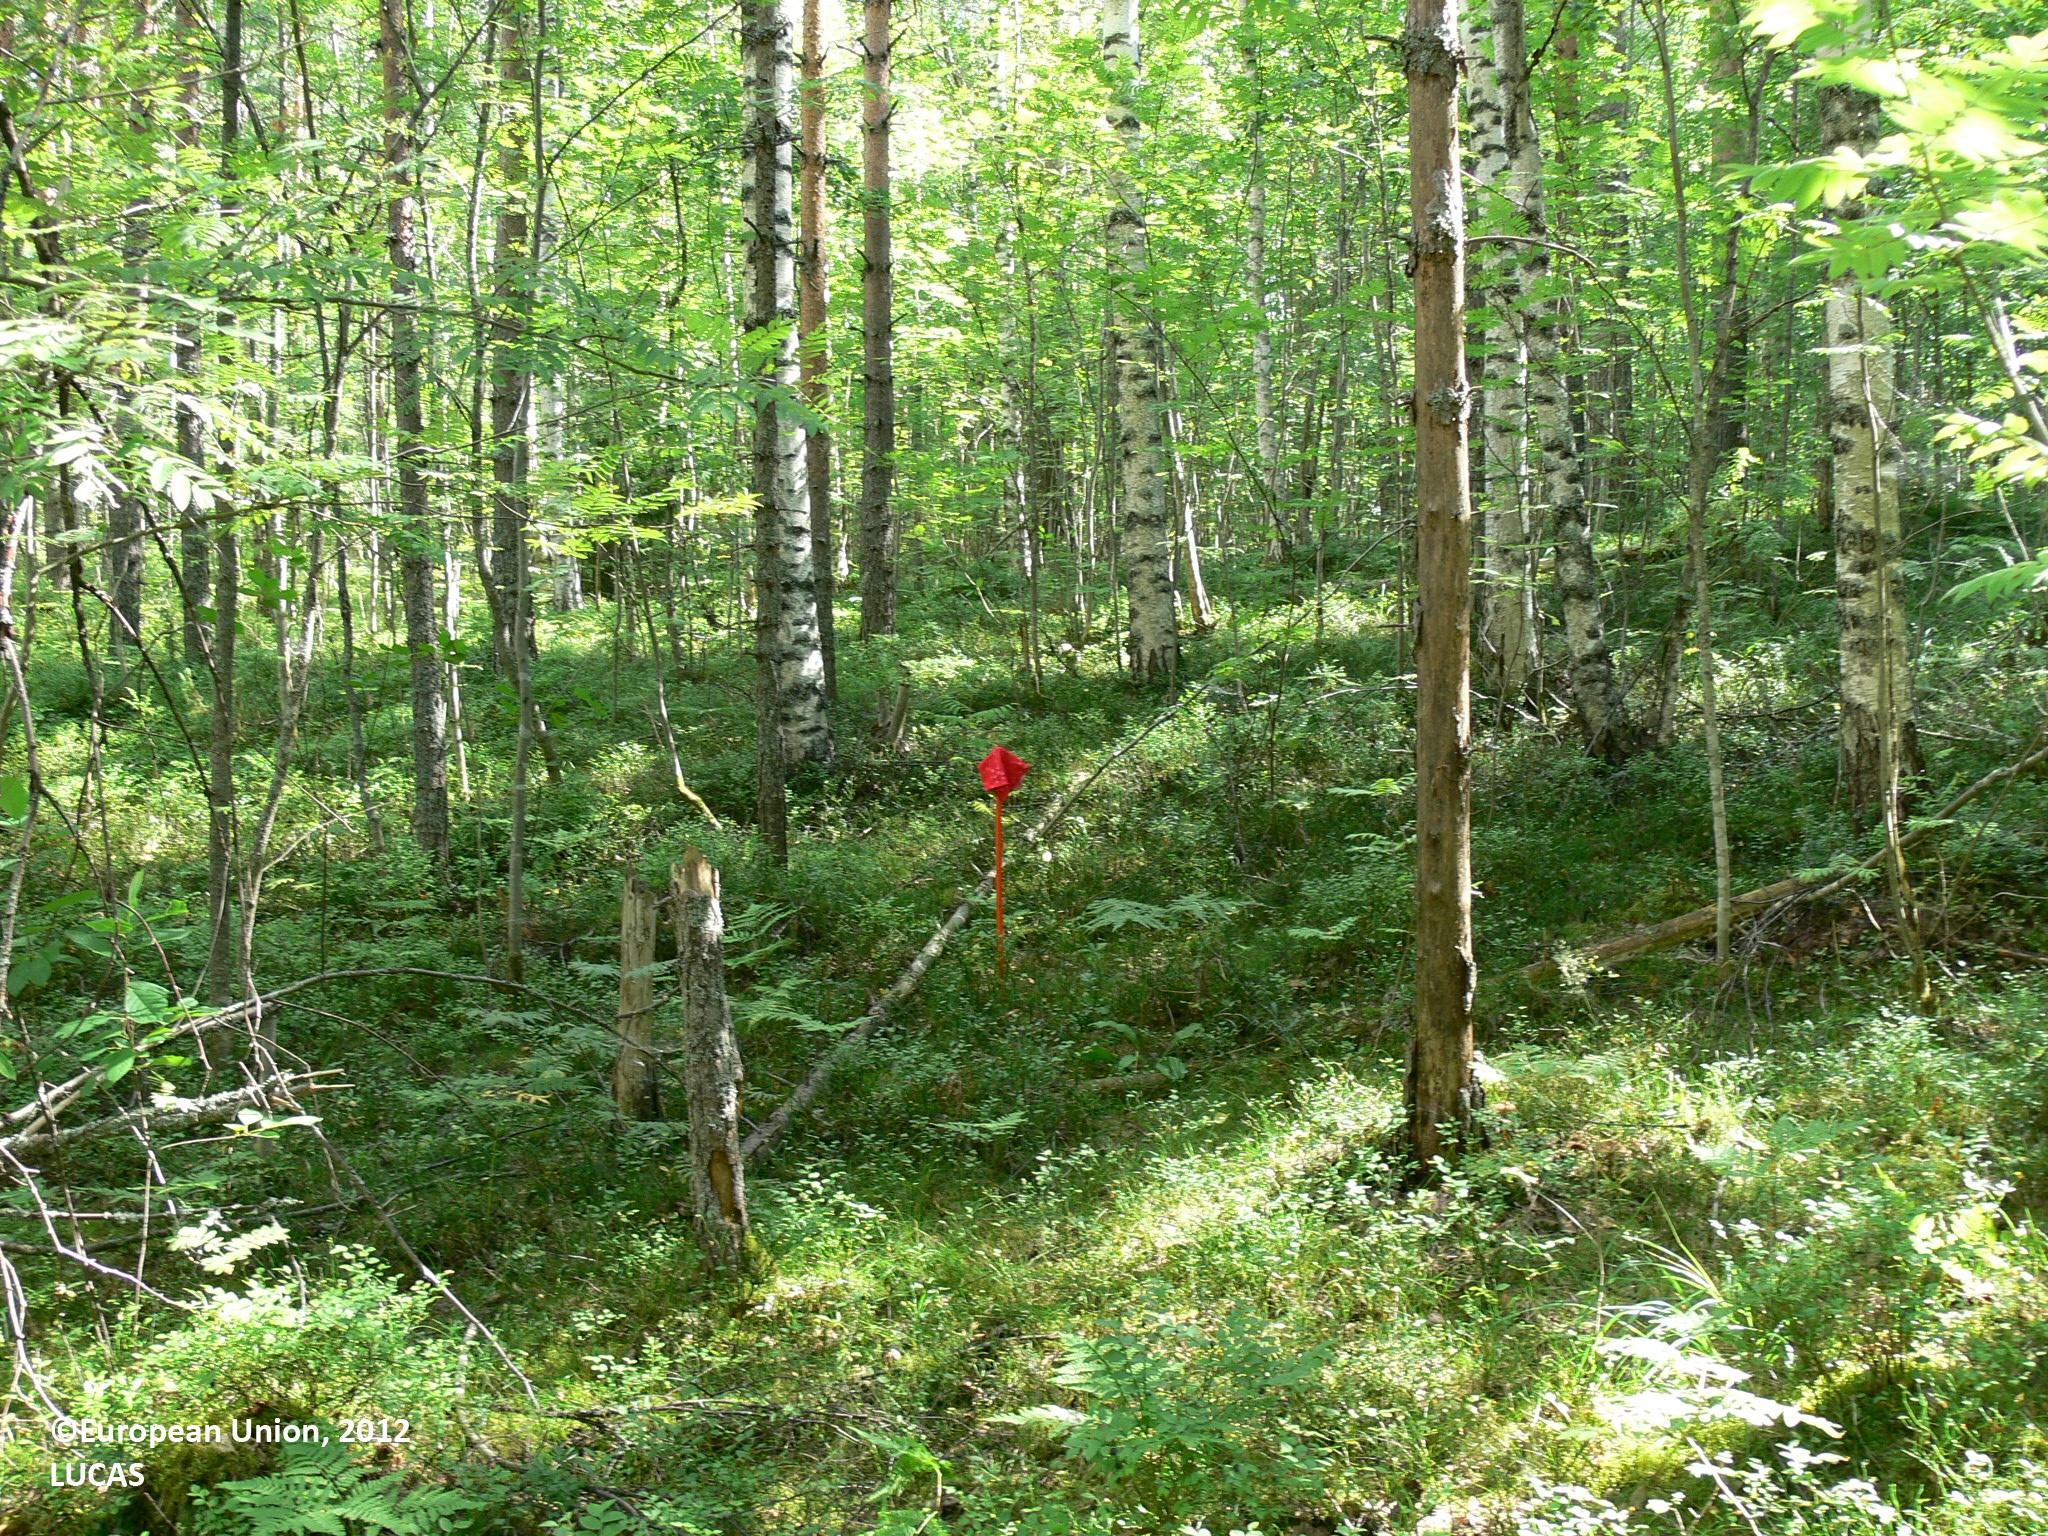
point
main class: Woodland
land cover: Pine dominated mixed woodland
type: boreal forest
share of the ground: > 75 %
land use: Forestry
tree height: > 5 m
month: August
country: FI
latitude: 62.0494
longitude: 29.4636
